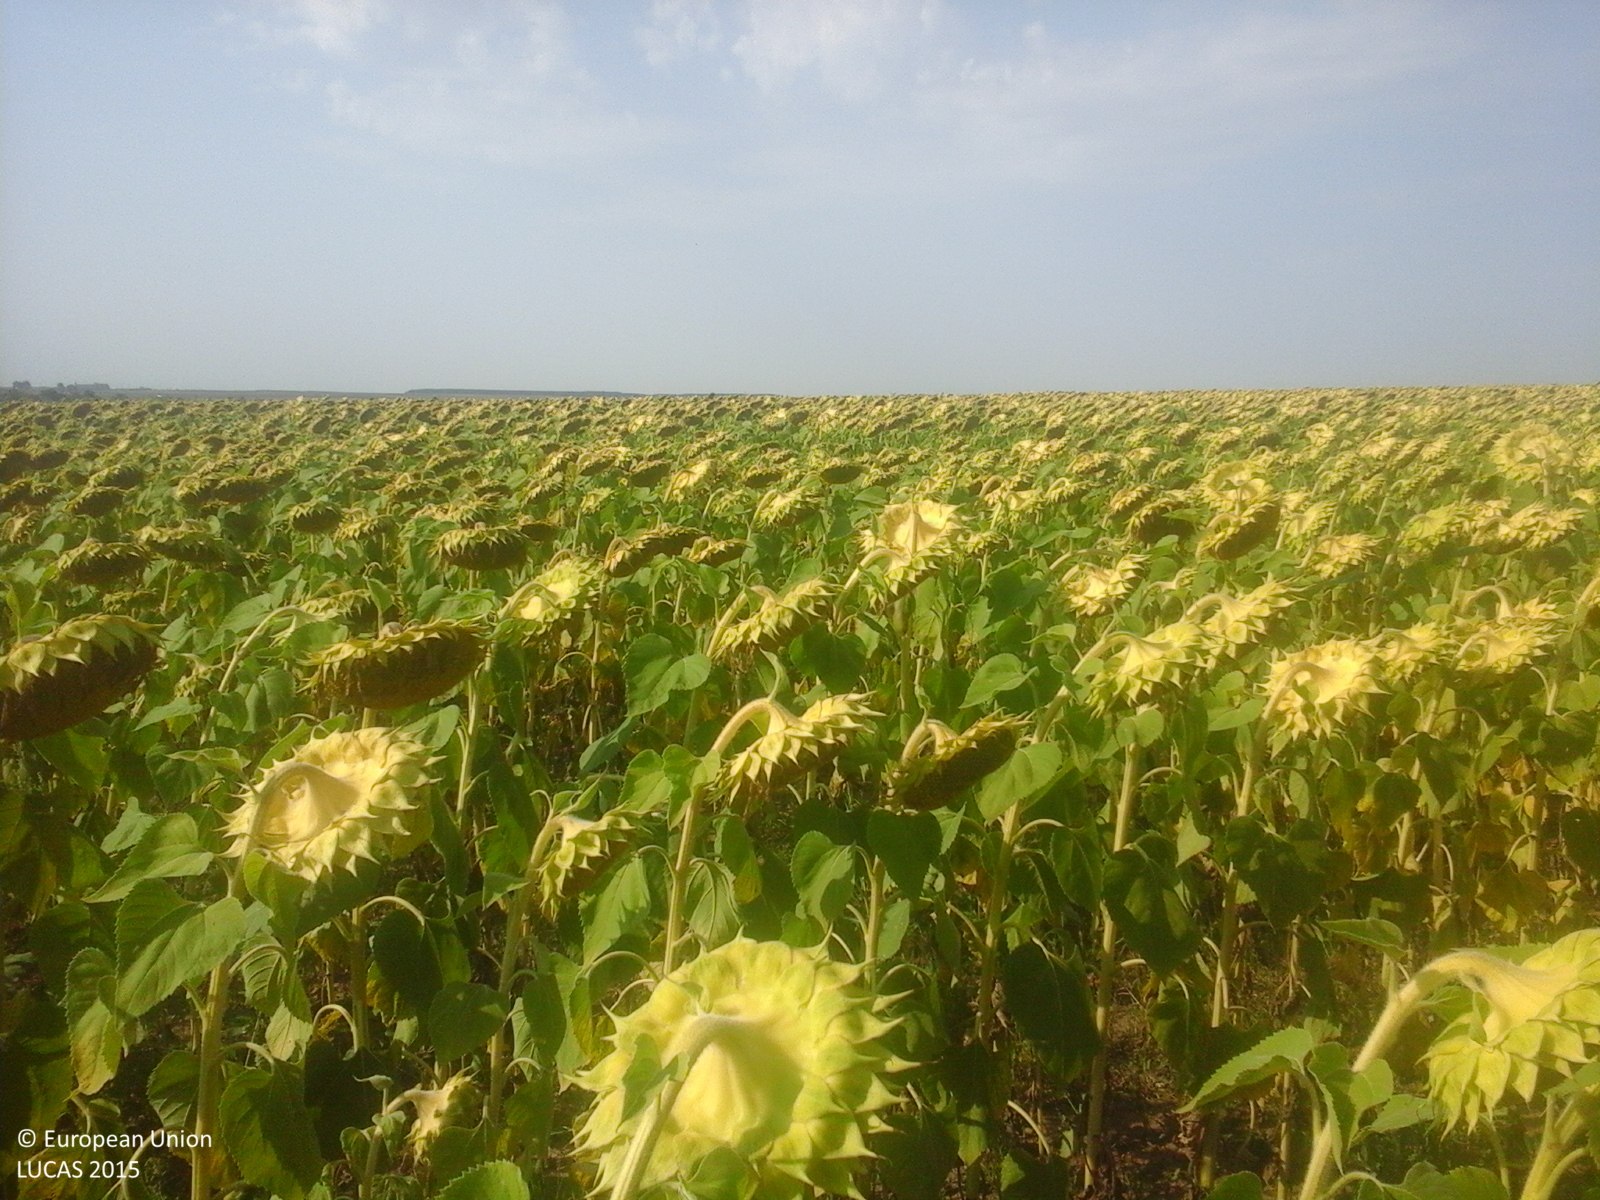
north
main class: Cropland
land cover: Sunflower
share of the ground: > 75 %
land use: Agriculture (excluding fallow land and kitchen gardens)
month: August
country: RO
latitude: 44.0015
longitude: 28.2812
